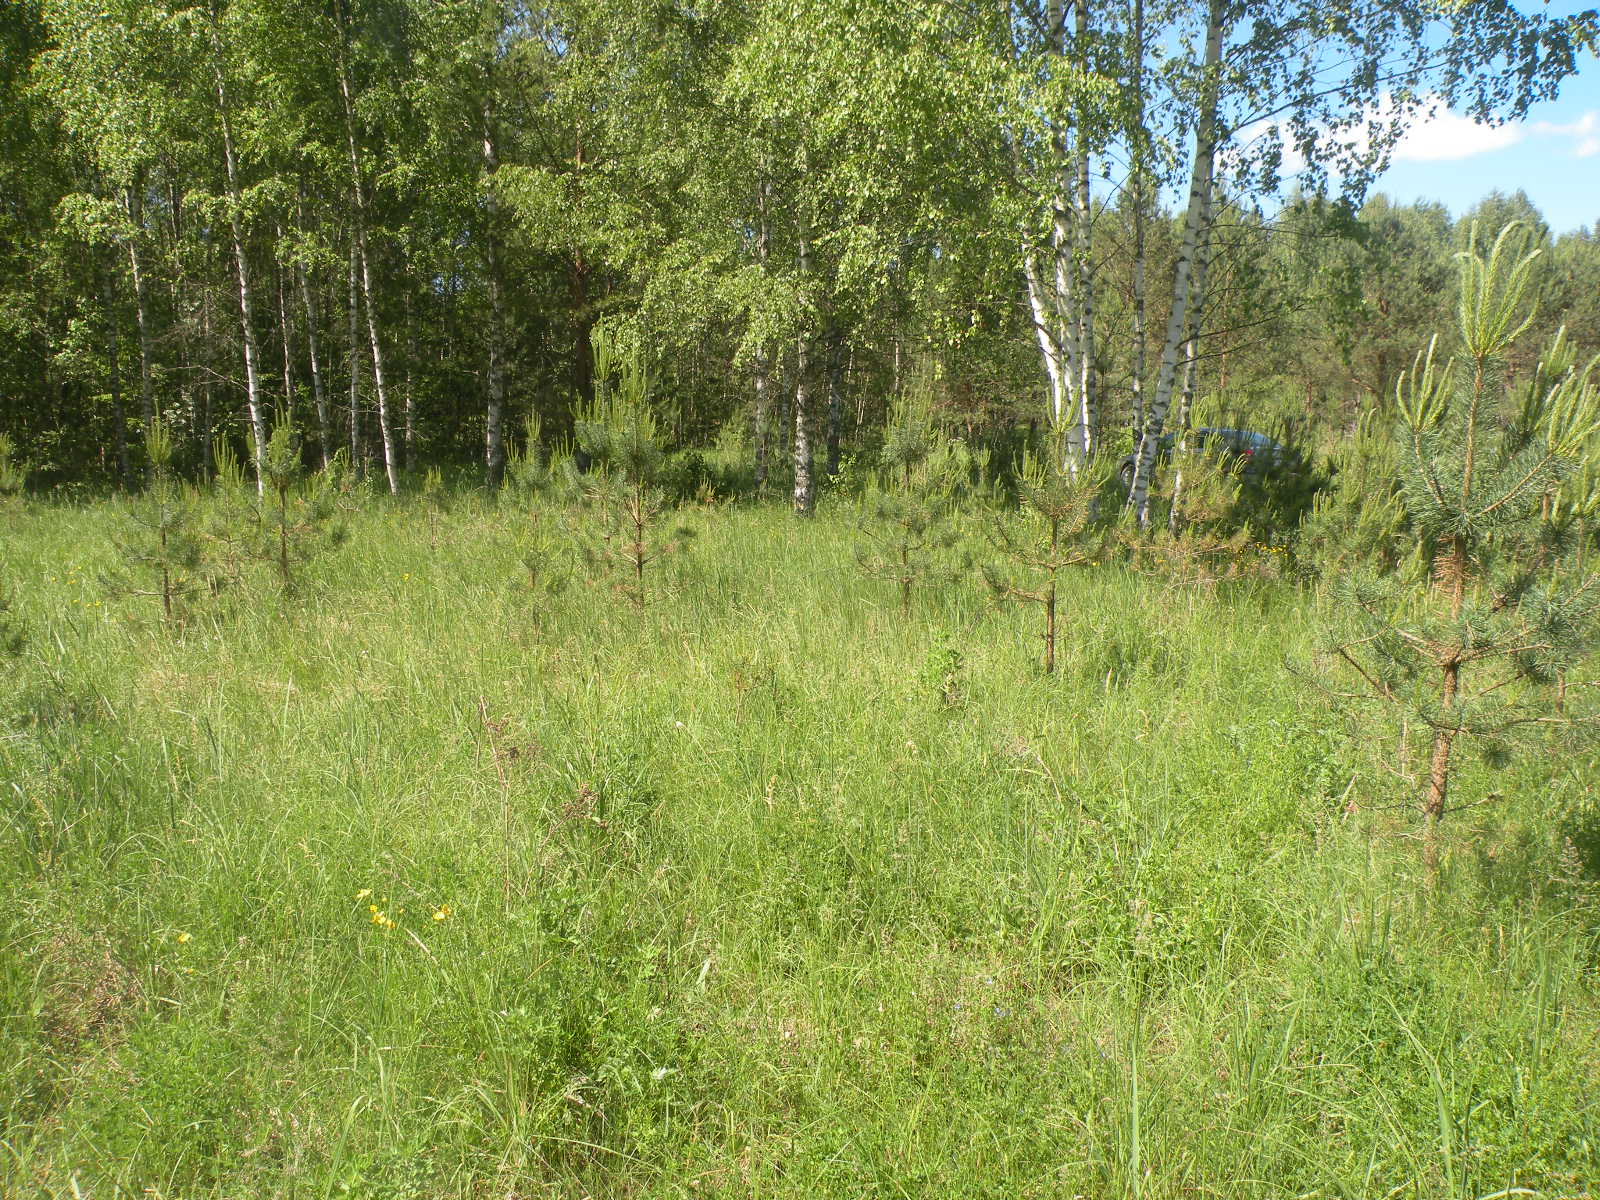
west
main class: Woodland
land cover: Pine dominated coniferous woodland
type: hemiboreal forest and nemoral coniferous forest and mixed broadleaved-coniferous forest
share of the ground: 25 - 50 %
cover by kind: herbaceous plants 55 %, coniferous forest trees 30 %, shrubs 10 %, broadleaved forest trees 5 %
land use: Forestry
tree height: < 5 m
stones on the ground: < 10 %
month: June
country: LV
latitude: 55.8866
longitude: 26.7372
